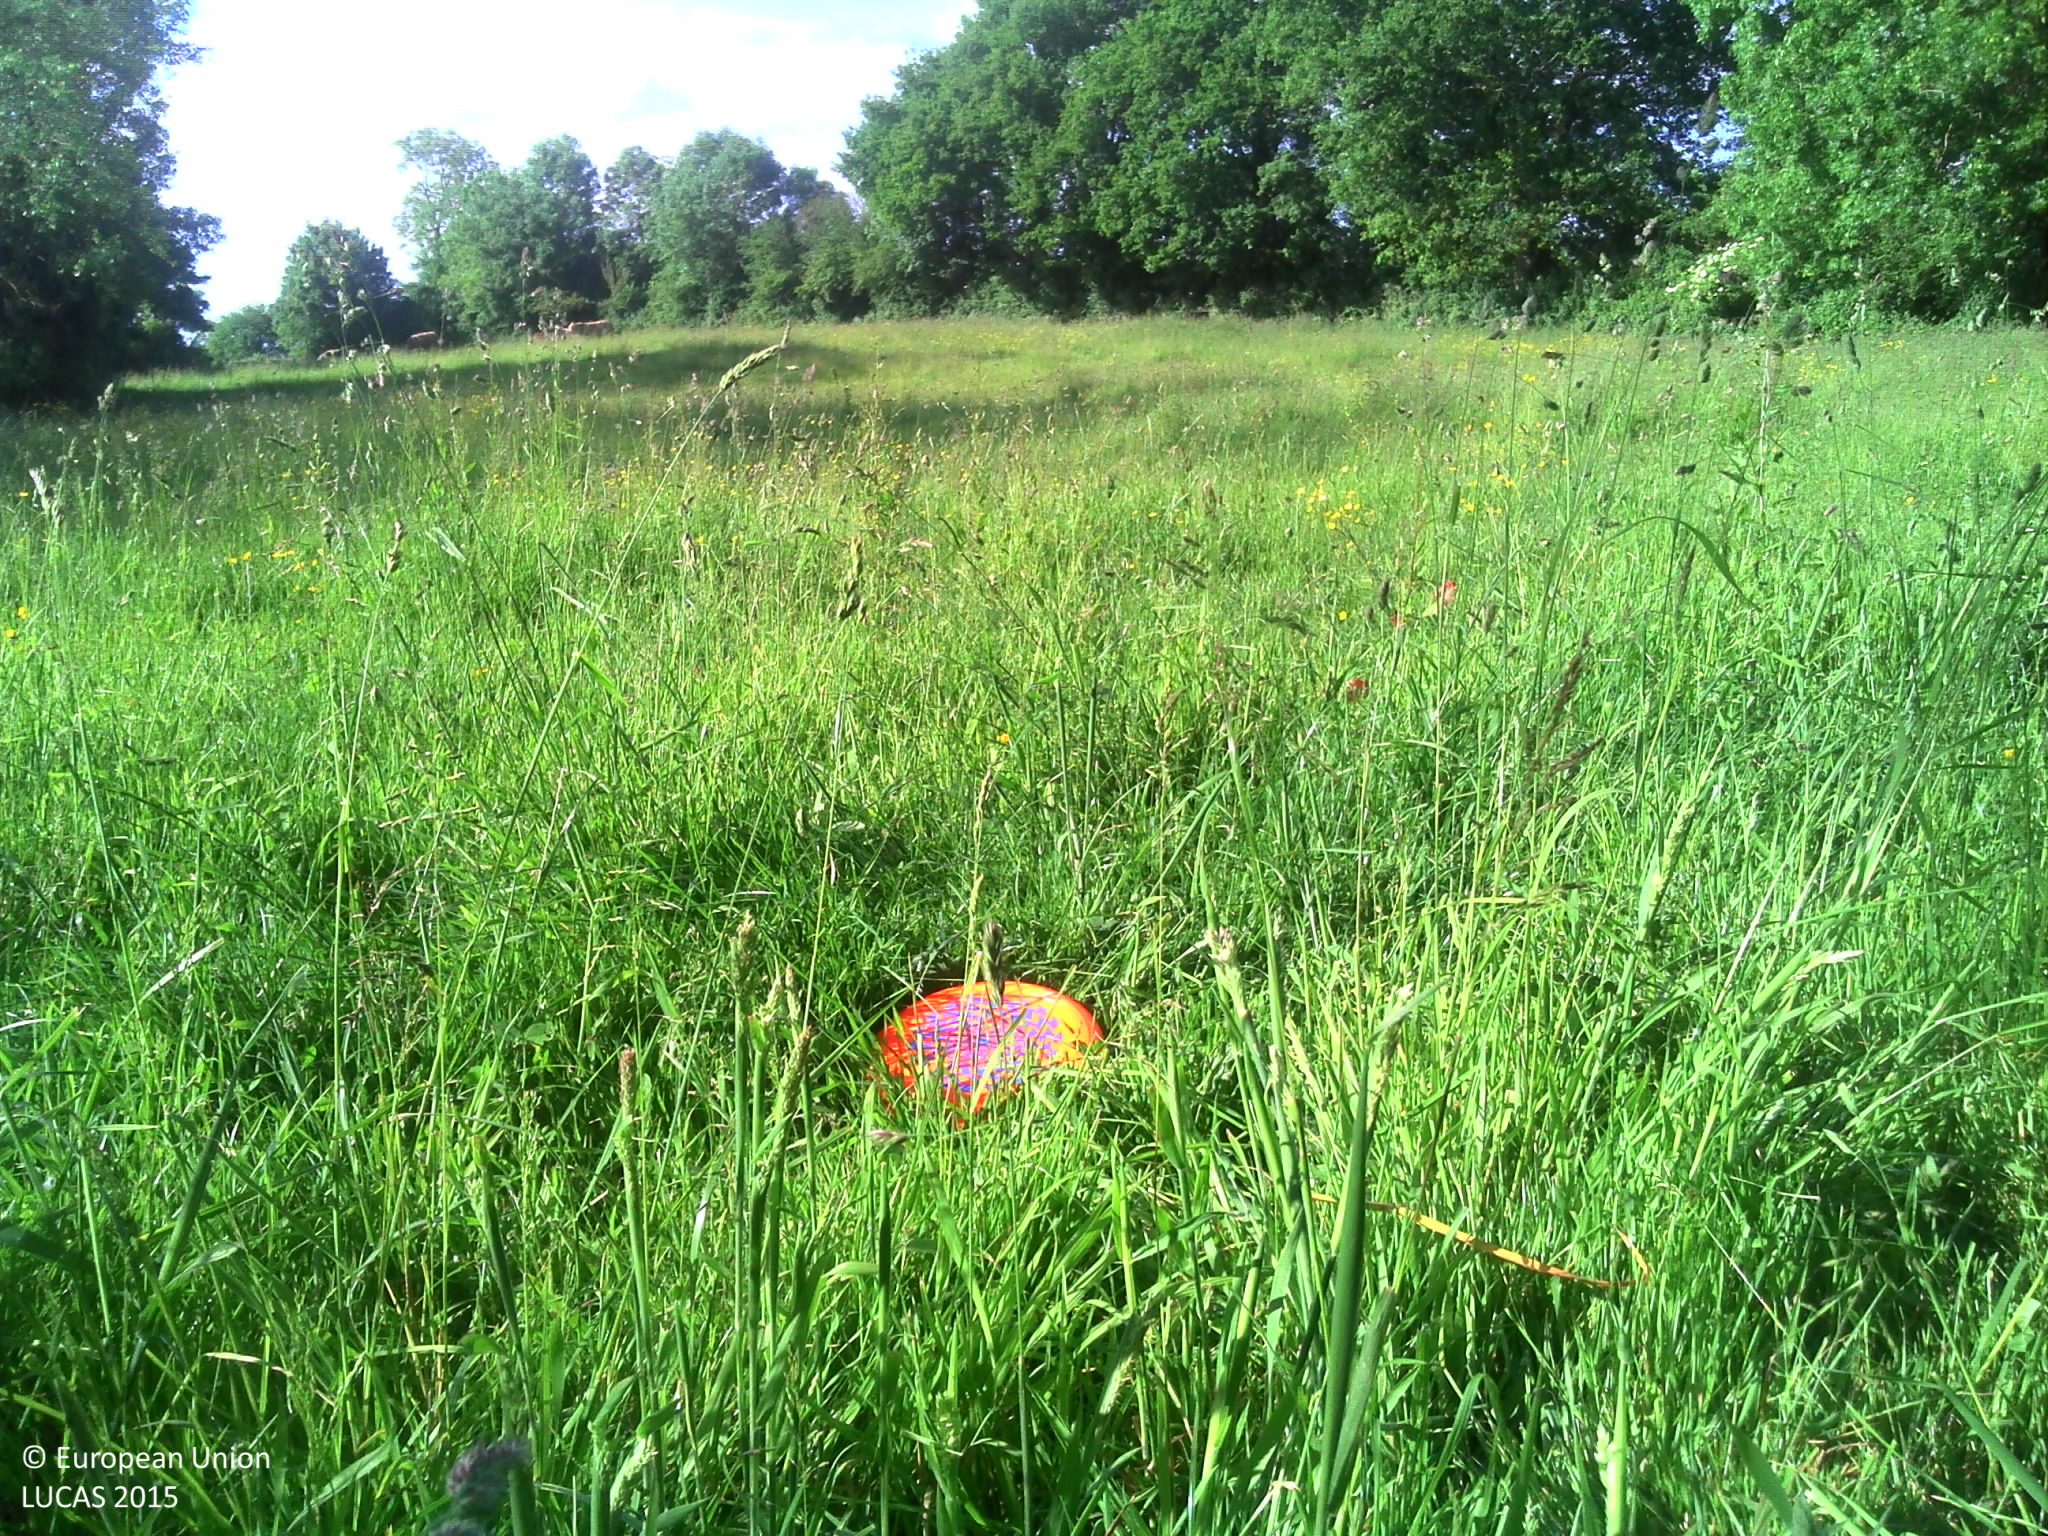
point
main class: Grassland
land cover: Grassland without tree/shrub cover
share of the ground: > 75 %
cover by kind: herbaceous plants 100 %
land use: Agriculture (excluding fallow land and kitchen gardens)
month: June
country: FR
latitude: 48.8301
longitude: 0.1218
